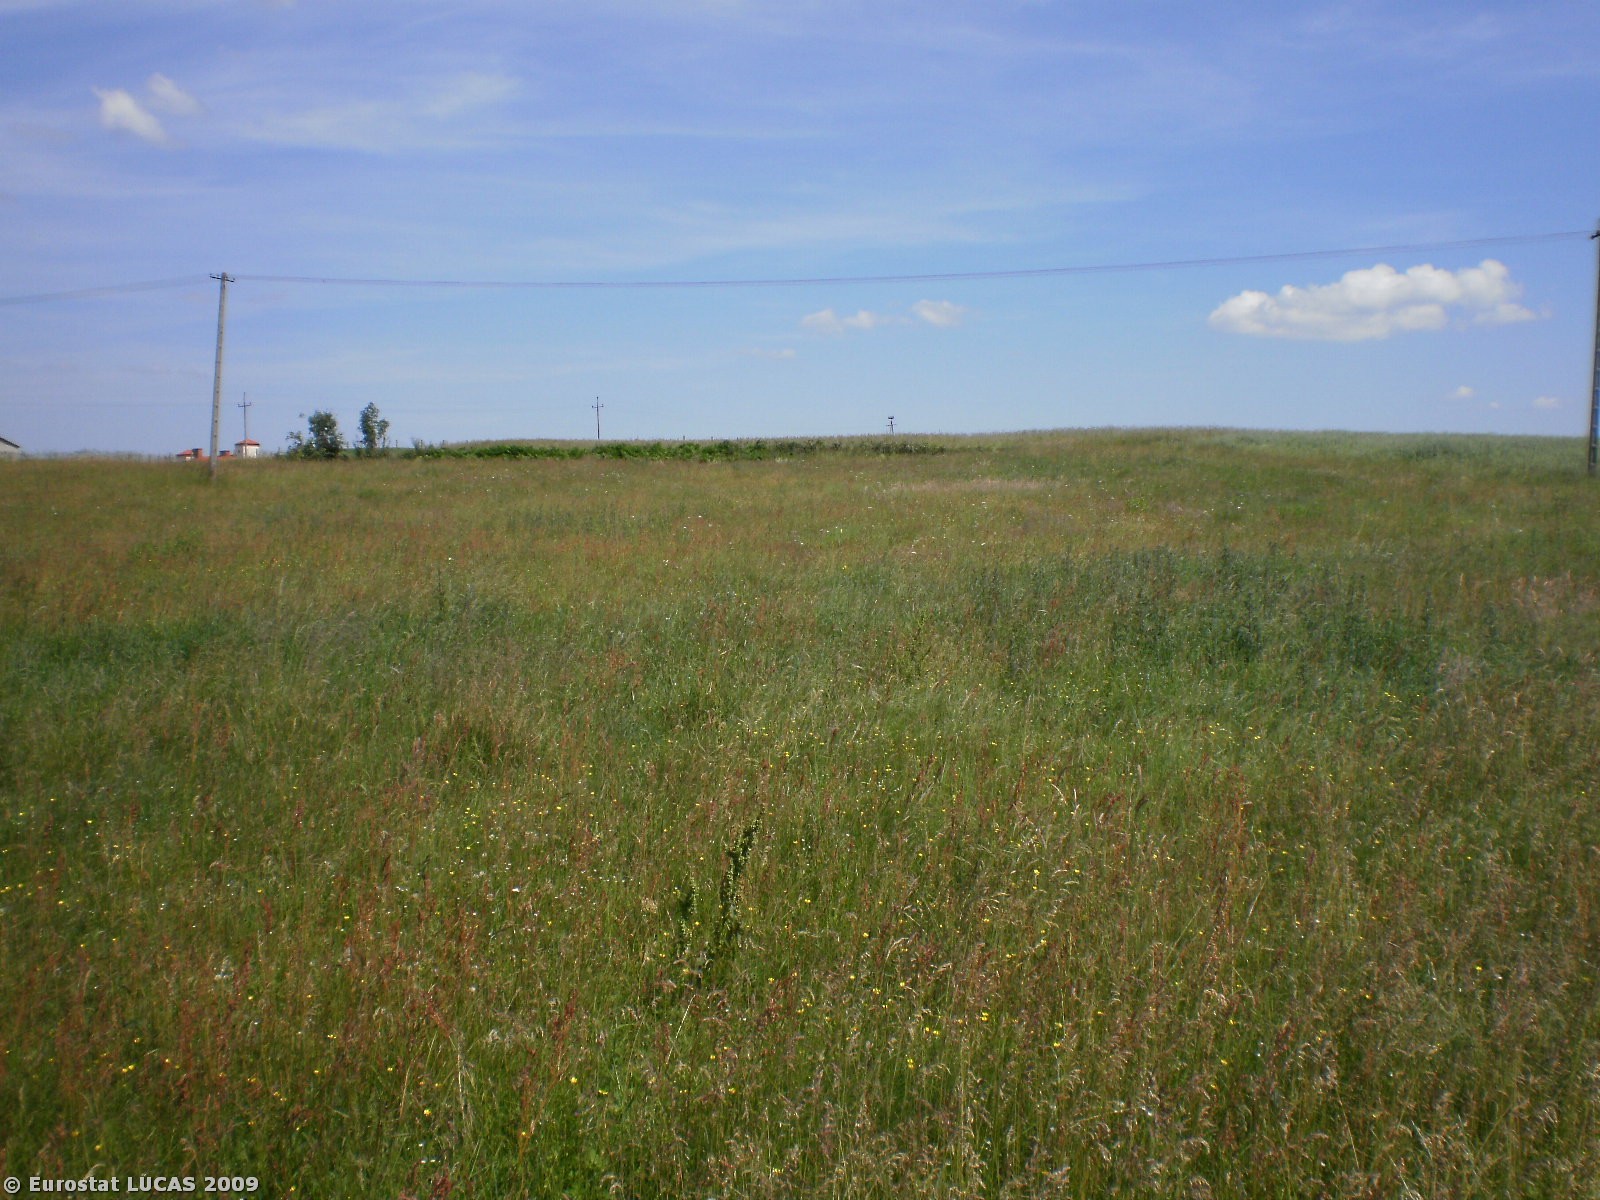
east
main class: Grassland
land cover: Grassland without tree/shrub cover
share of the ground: > 75 %
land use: Agriculture (excluding fallow land and kitchen gardens)
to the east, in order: Grassland without tree/shrub cover; Electric lines; Grassland without tree/shrub cover; Grass margins; Tracks; Rye
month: July
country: PL
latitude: 54.3160
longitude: 17.9301
